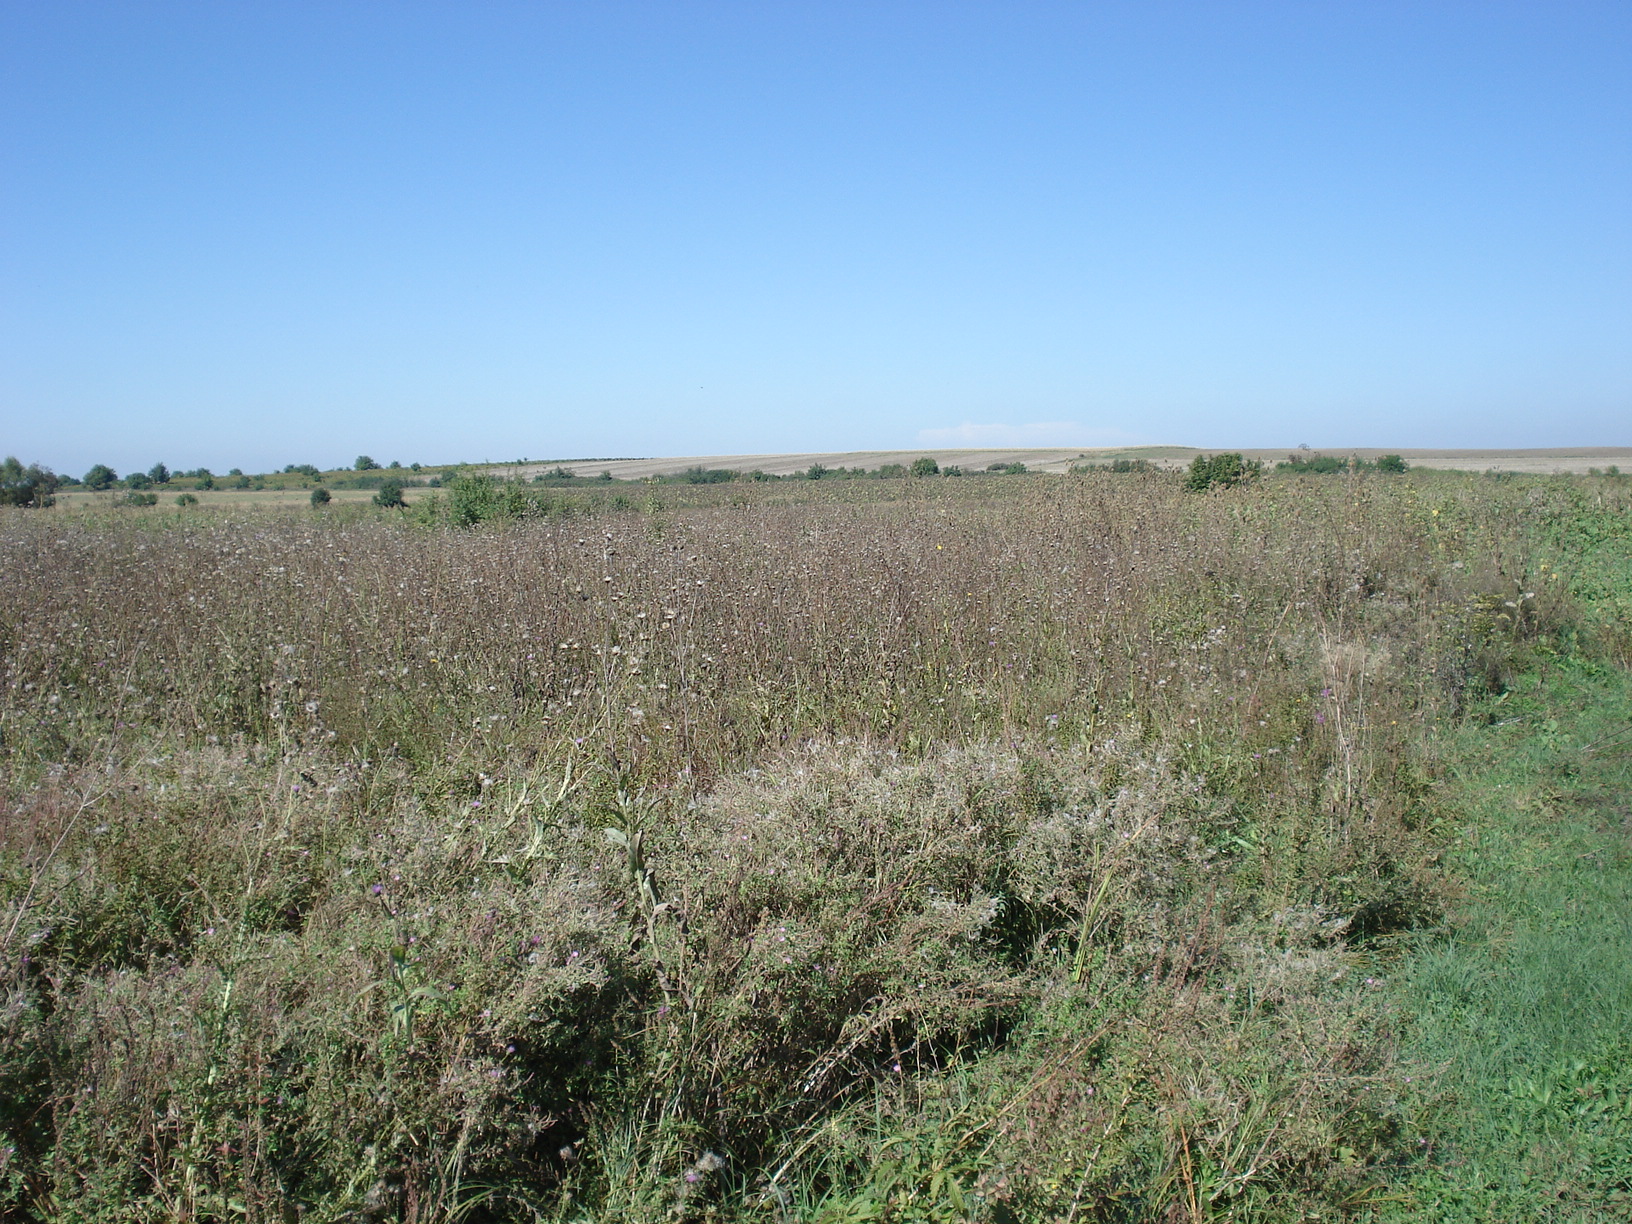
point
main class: Grassland
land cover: Grassland without tree/shrub cover
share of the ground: > 75 %
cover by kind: herbaceous plants 100 %
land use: Semi-natural and natural areas not in use
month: September
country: BG
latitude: 43.2895
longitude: 25.2457
